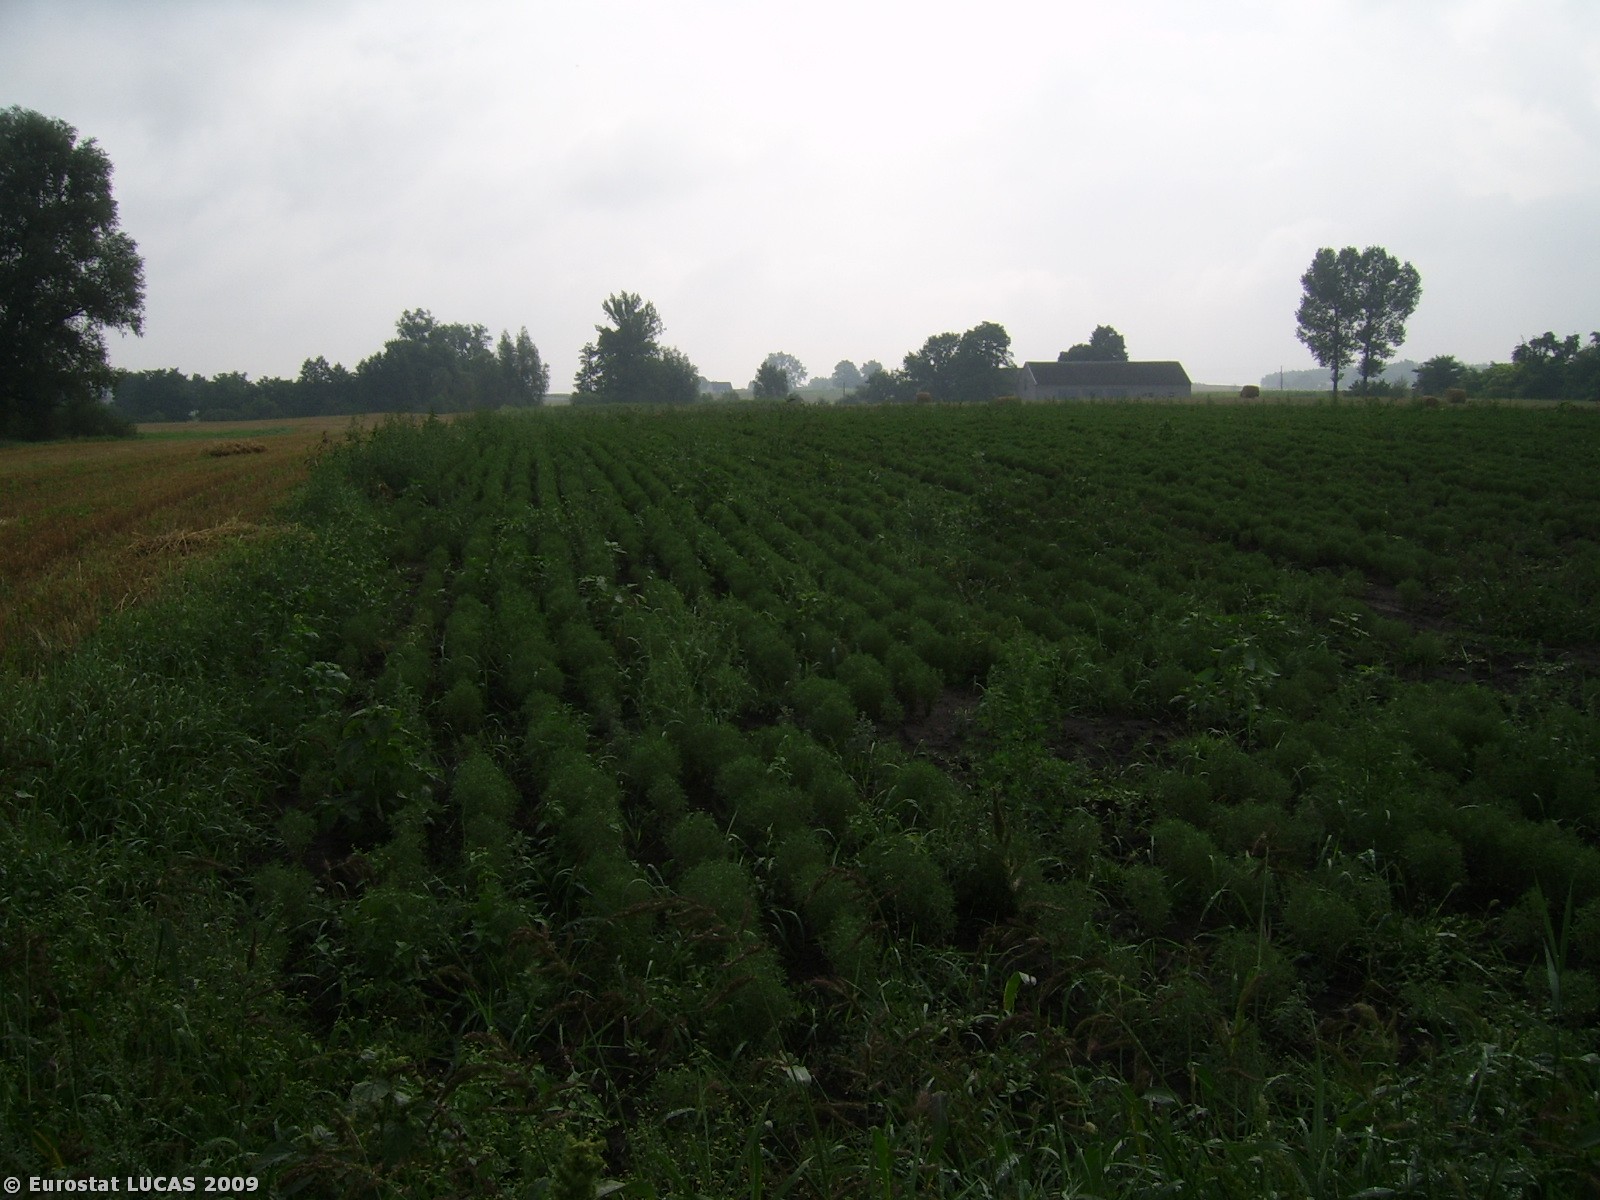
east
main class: Grassland
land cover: Grassland without tree/shrub cover
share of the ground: > 75 %
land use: Agriculture (excluding fallow land and kitchen gardens)
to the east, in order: Grassland without tree/shrub cover; Other non-permanent industrial crops
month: August
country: PL
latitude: 52.5676
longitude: 18.6509
